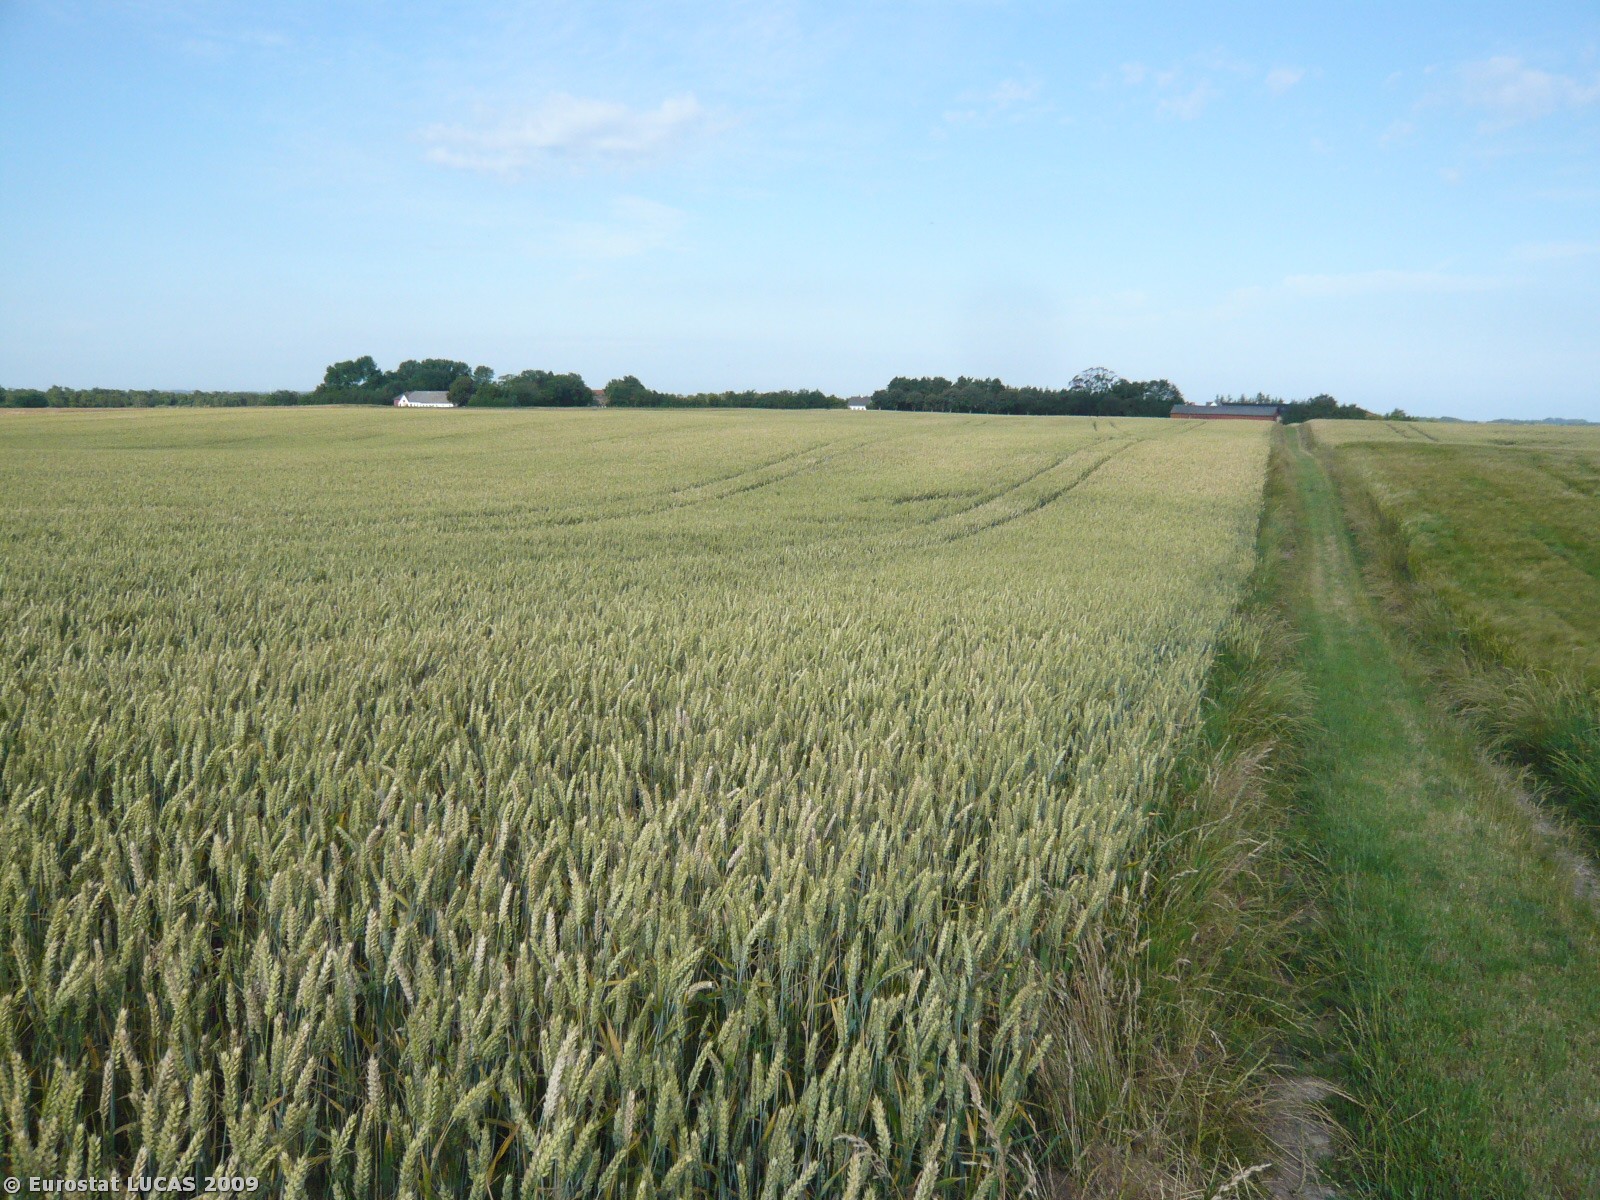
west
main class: Cropland
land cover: Common wheat
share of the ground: > 75 %
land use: Agriculture (excluding fallow land and kitchen gardens)
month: July
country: DK
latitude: 55.7325
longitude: 11.2250
